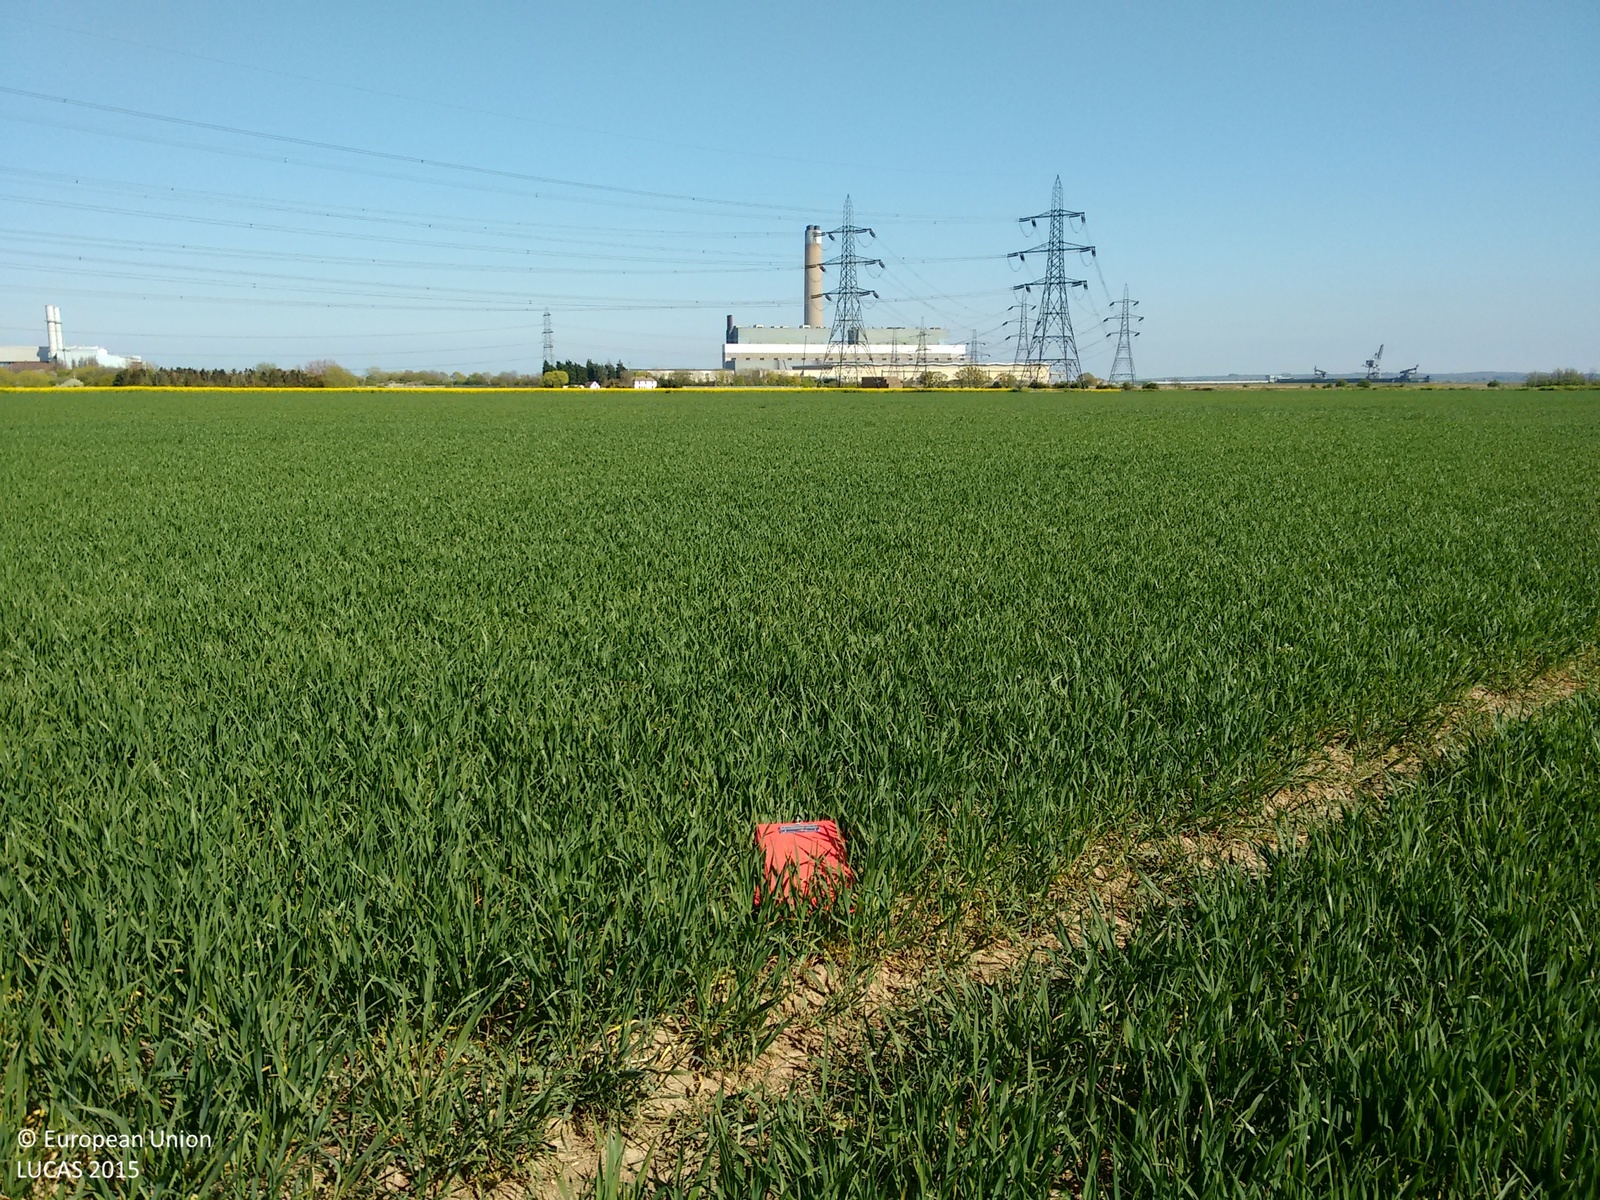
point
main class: Cropland
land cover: Common wheat
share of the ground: > 75 %
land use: Agriculture (excluding fallow land and kitchen gardens)
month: April
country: GB
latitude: 51.4230
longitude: 0.5820
